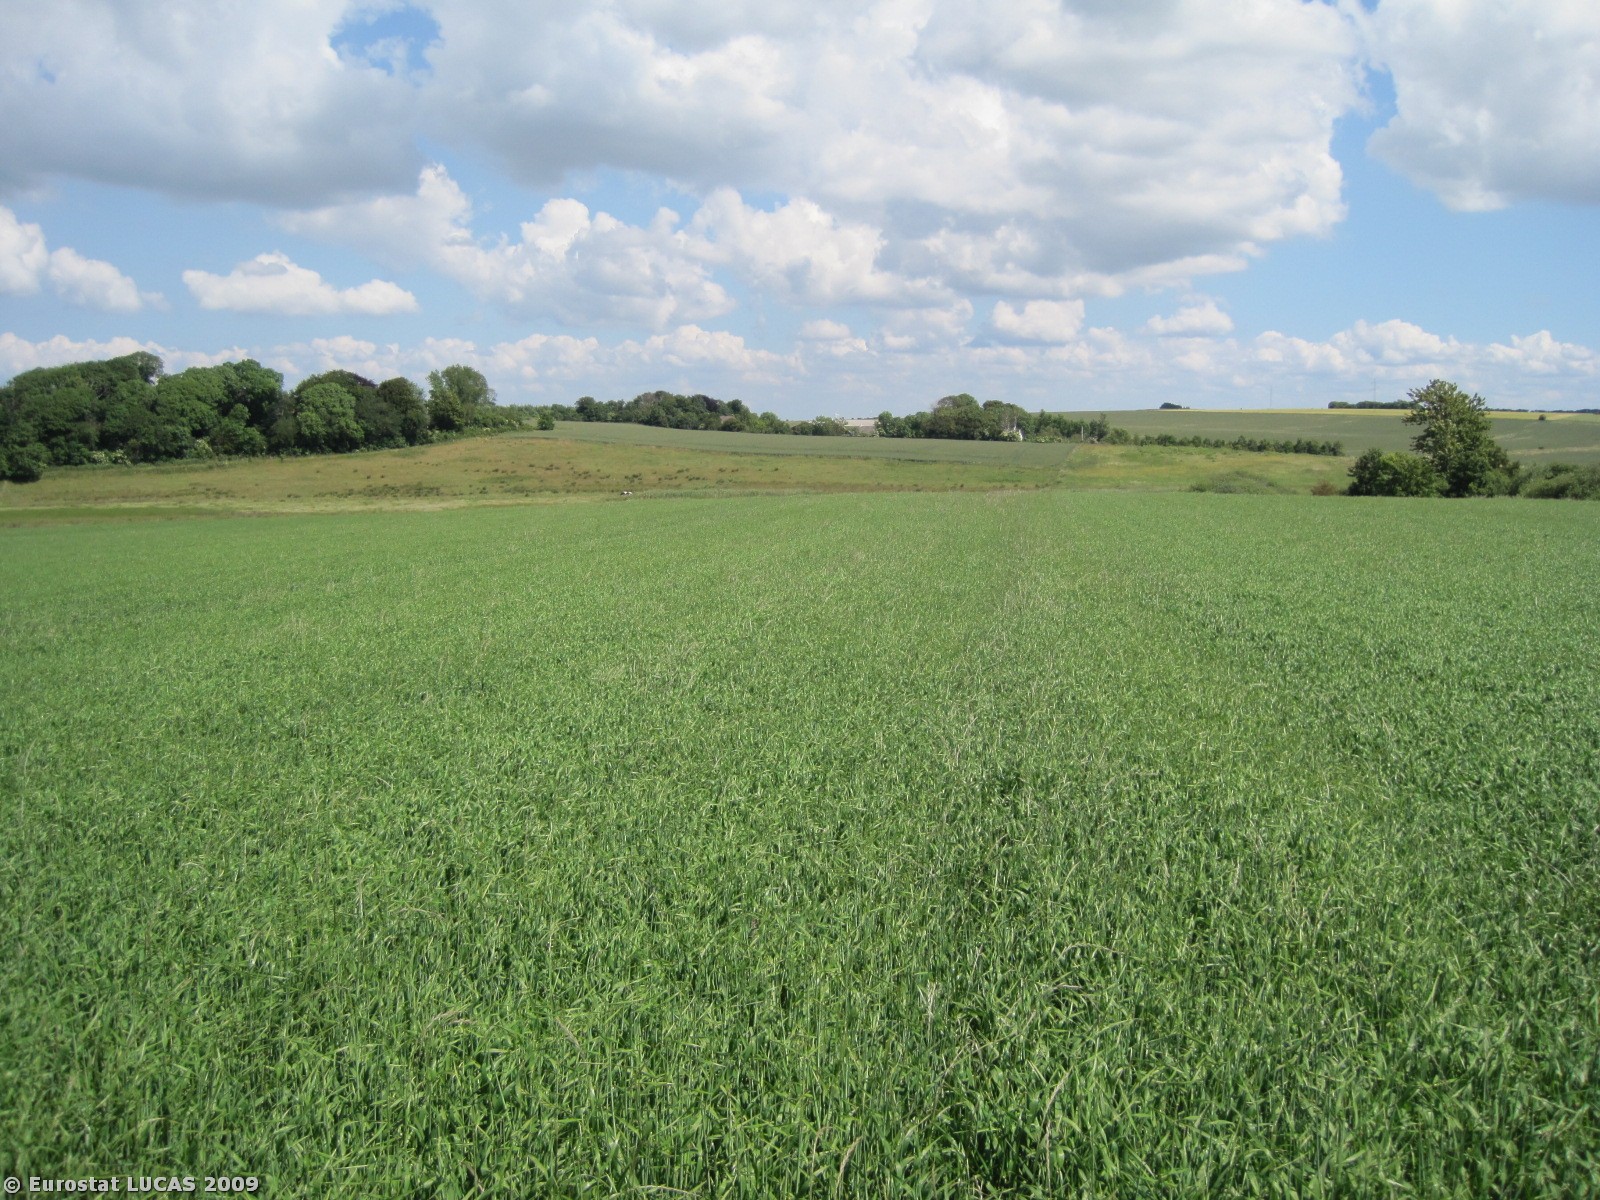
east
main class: Cropland
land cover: Barley
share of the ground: > 75 %
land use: Agriculture (excluding fallow land and kitchen gardens)
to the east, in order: Barley; Grass margins; Fences; Grass margins; Grassland without tree/shrub cover
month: June
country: DK
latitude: 56.6682
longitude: 8.8756
